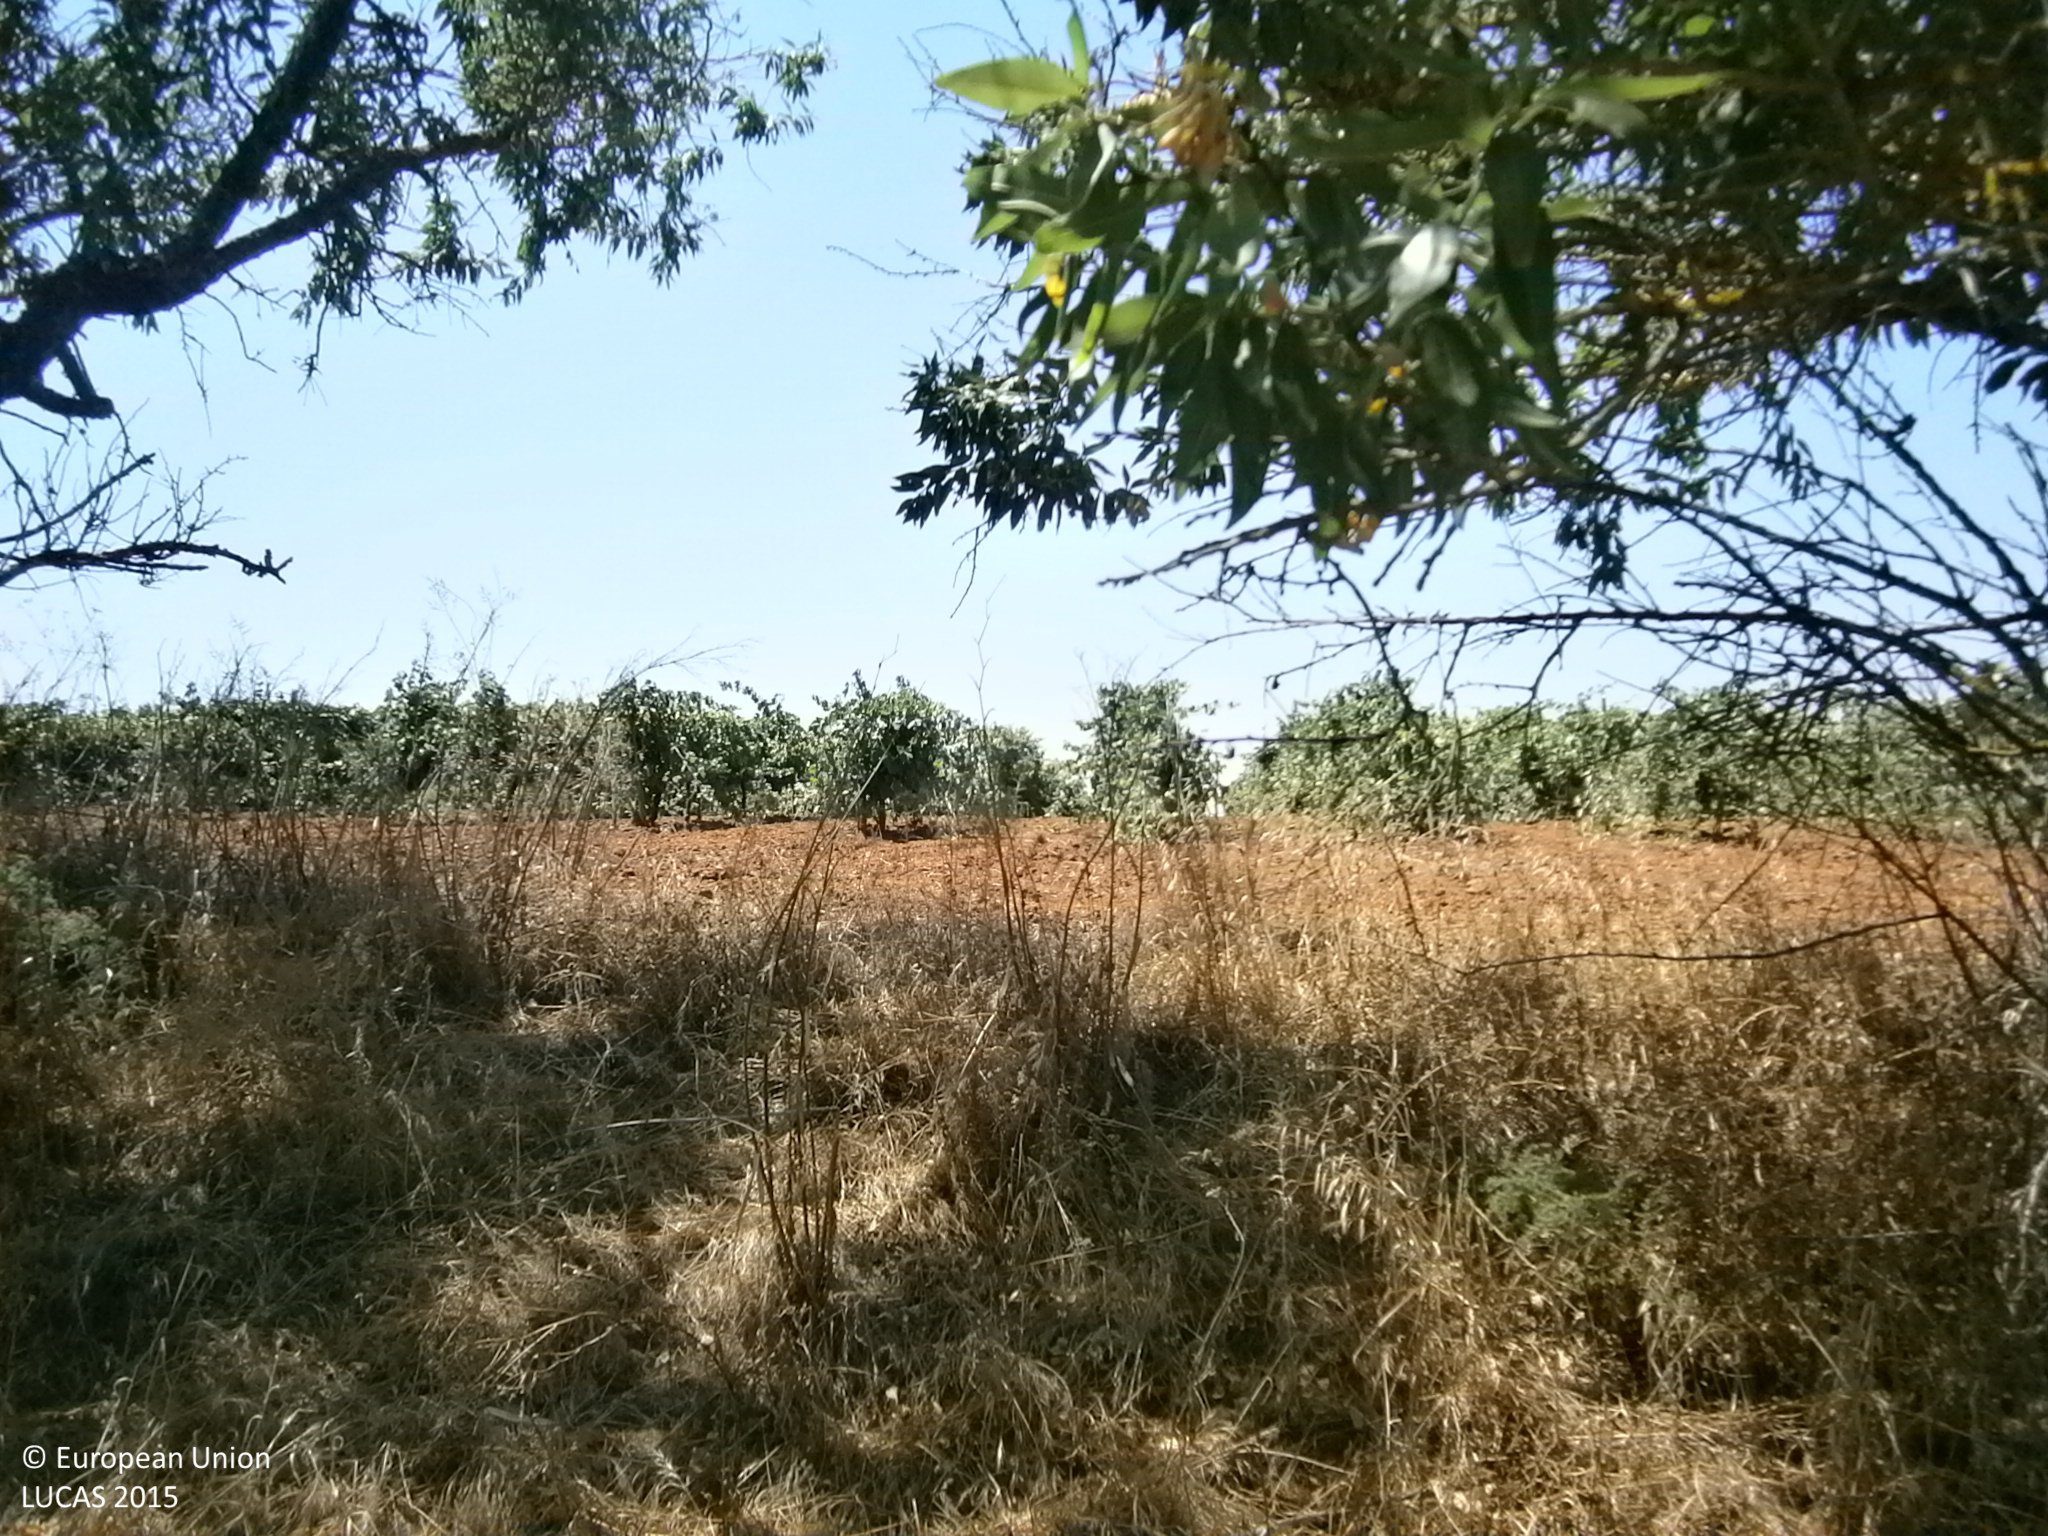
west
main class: Cropland
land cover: Nuts trees
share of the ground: > 75 %
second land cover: Spontaneously vegetated surfaces
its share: 25 - 50 %
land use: Agriculture (excluding fallow land and kitchen gardens)
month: June
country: ES
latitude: 38.8312
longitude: -6.6619
